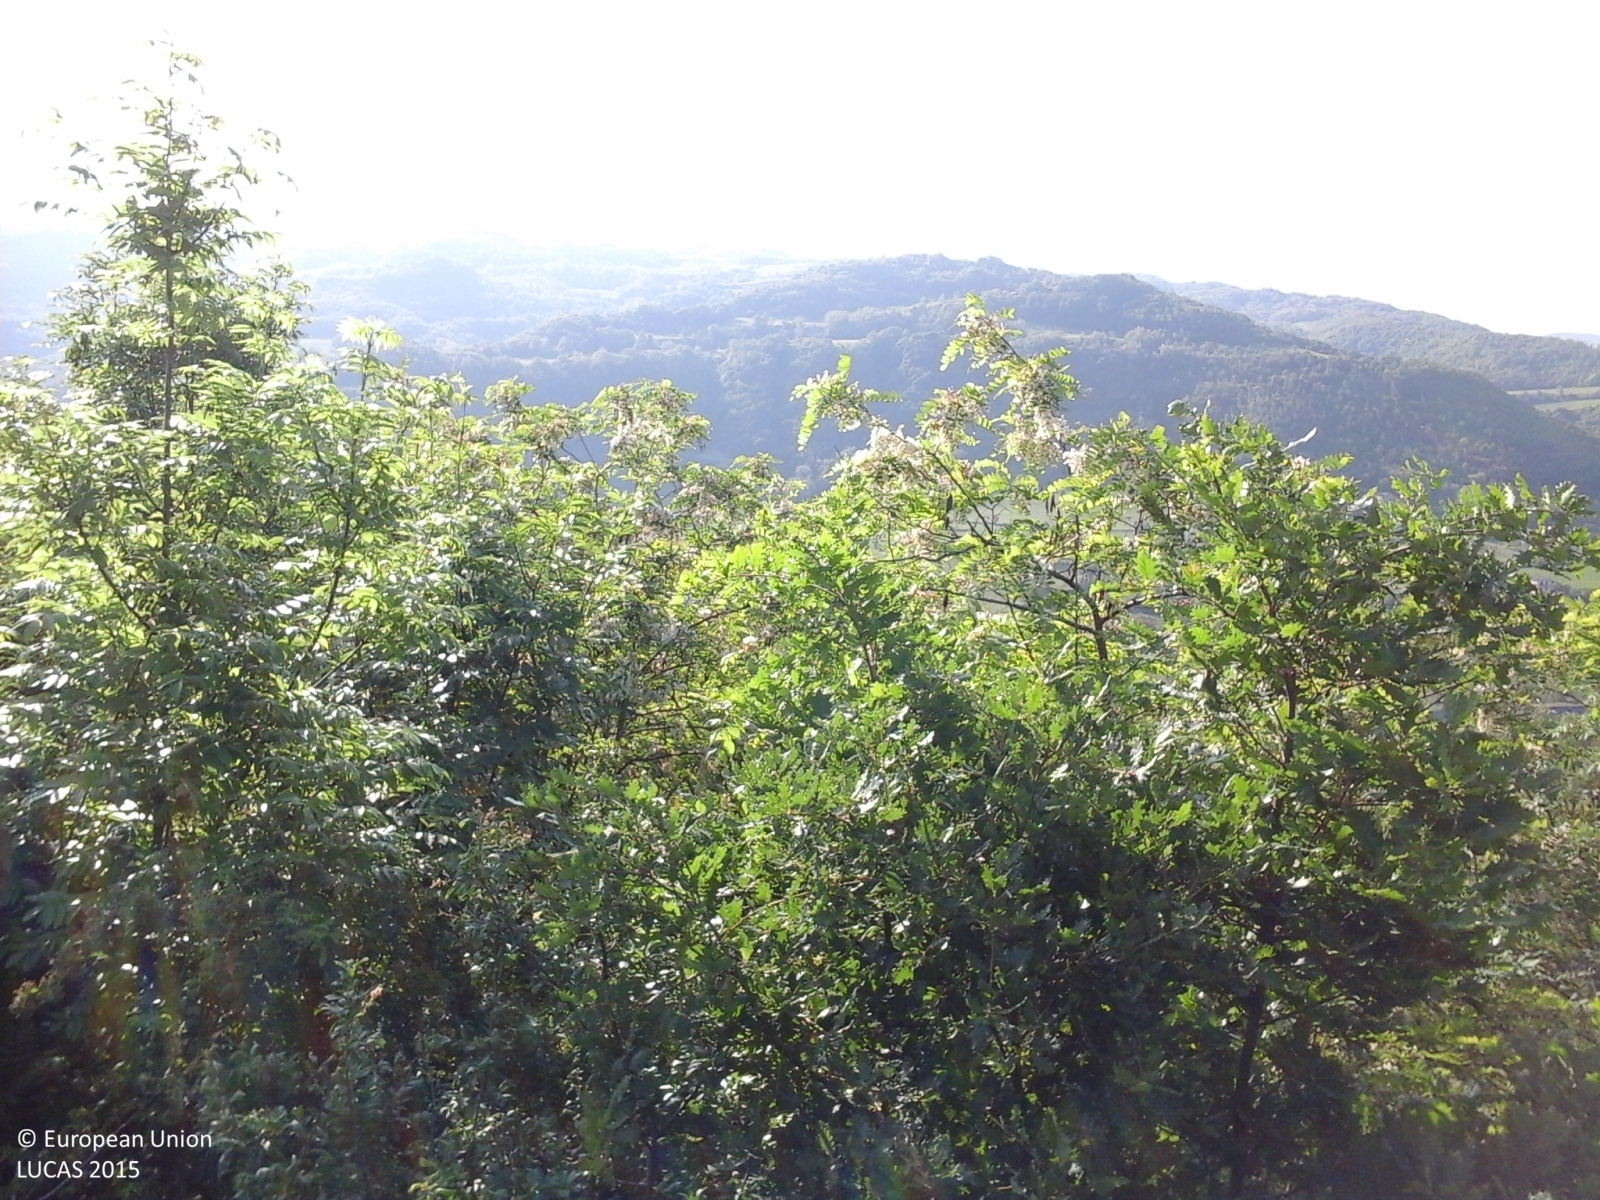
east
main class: Woodland
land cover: Broadleaved woodland
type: mesophytic deciduous forest
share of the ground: > 75 %
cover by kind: broadleaved forest trees 100 %
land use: Forestry
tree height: > 5 m
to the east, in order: Broadleaved woodland; Electric lines; Paved roads, cycling and walking lanes; Broadleaved woodland; Grassland without tree/shrub cover
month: May
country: IT
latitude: 44.7635
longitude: 9.3822
